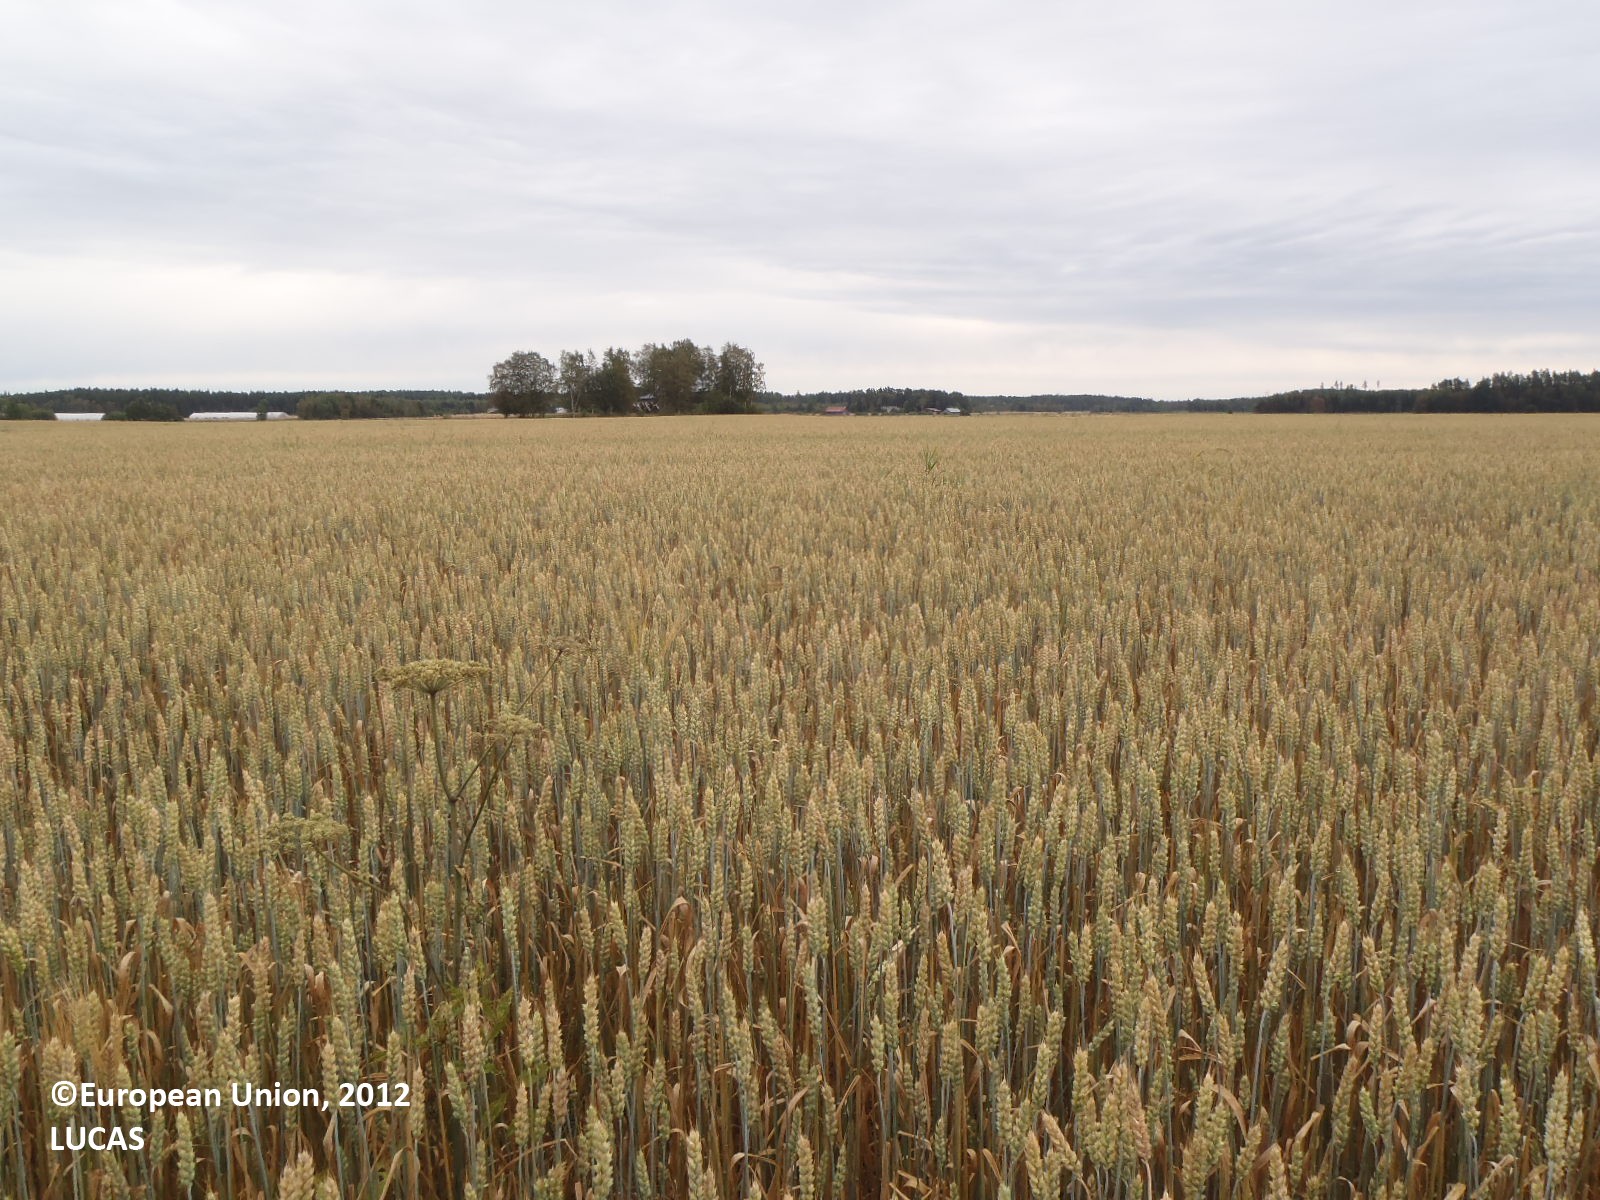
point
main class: Cropland
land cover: Common wheat
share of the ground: > 75 %
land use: Agriculture (excluding fallow land and kitchen gardens)
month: August
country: FI
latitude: 60.8697
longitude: 21.7887
